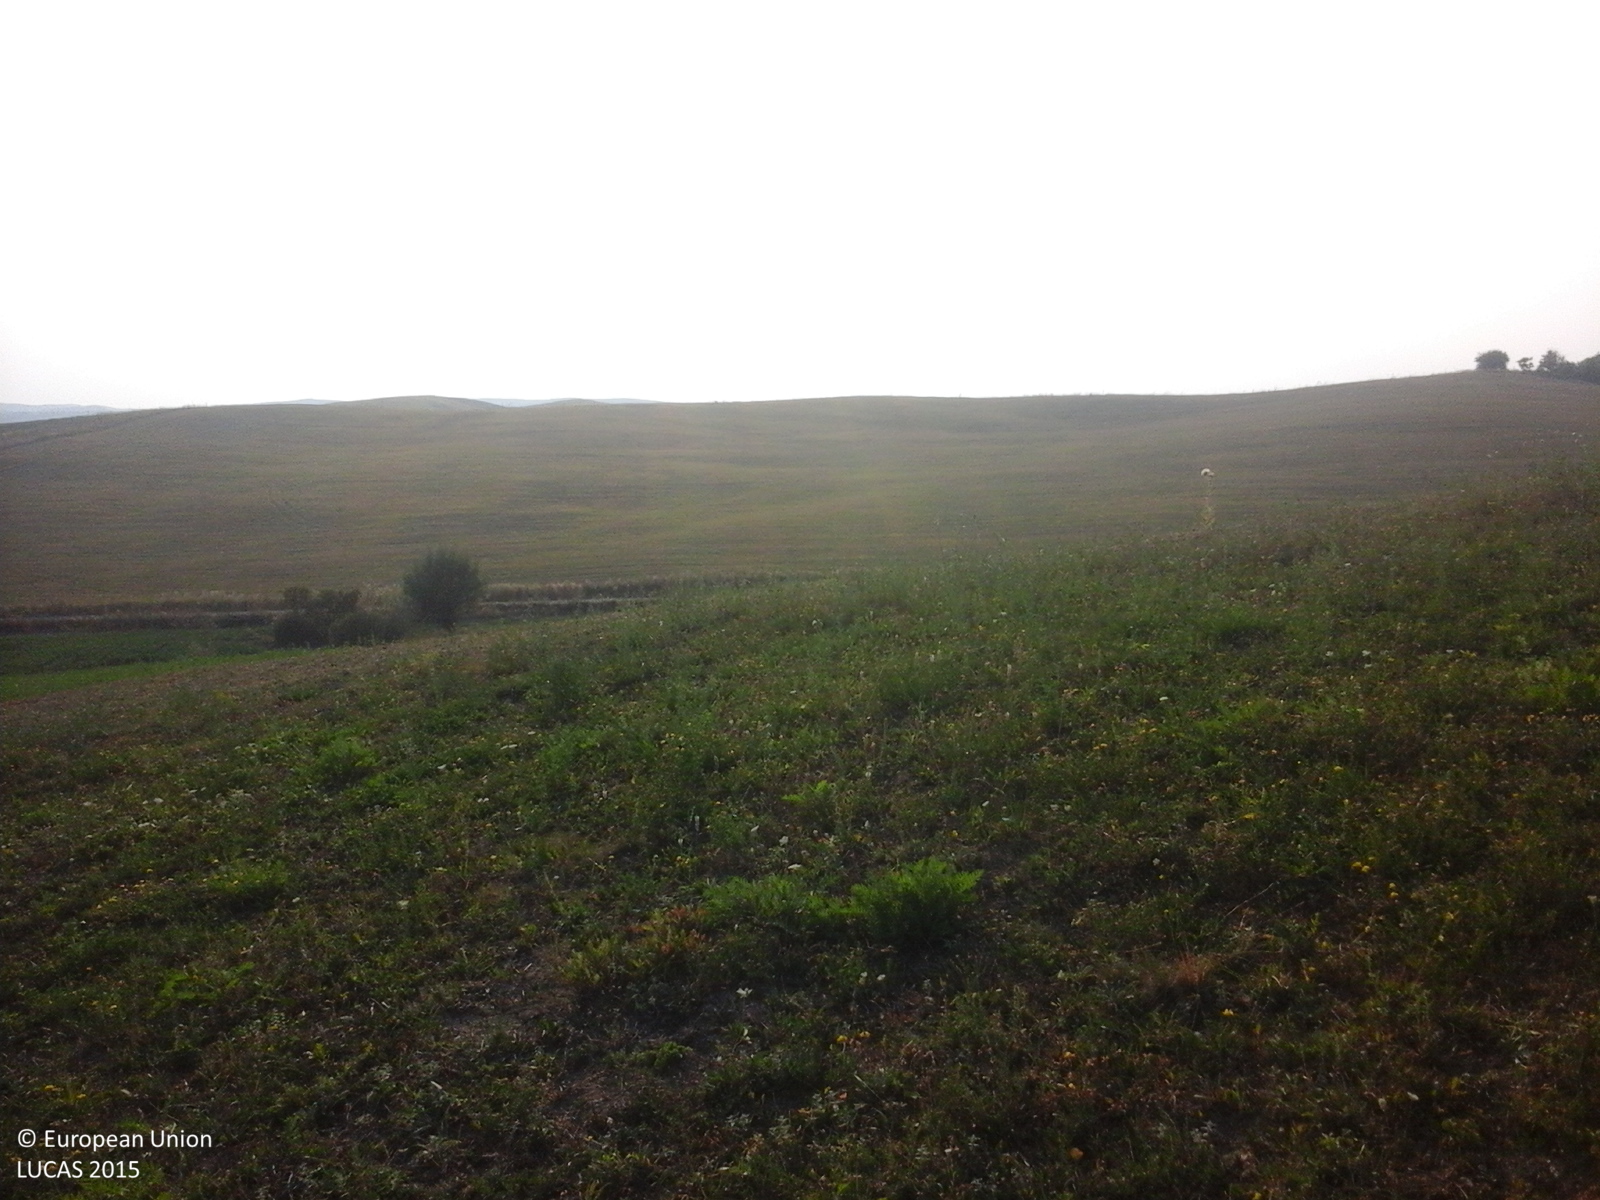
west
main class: Grassland
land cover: Grassland without tree/shrub cover
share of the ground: > 75 %
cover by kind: herbaceous plants 100 %
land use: Agriculture (excluding fallow land and kitchen gardens)
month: September
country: RO
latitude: 47.2148
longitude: 24.4162
